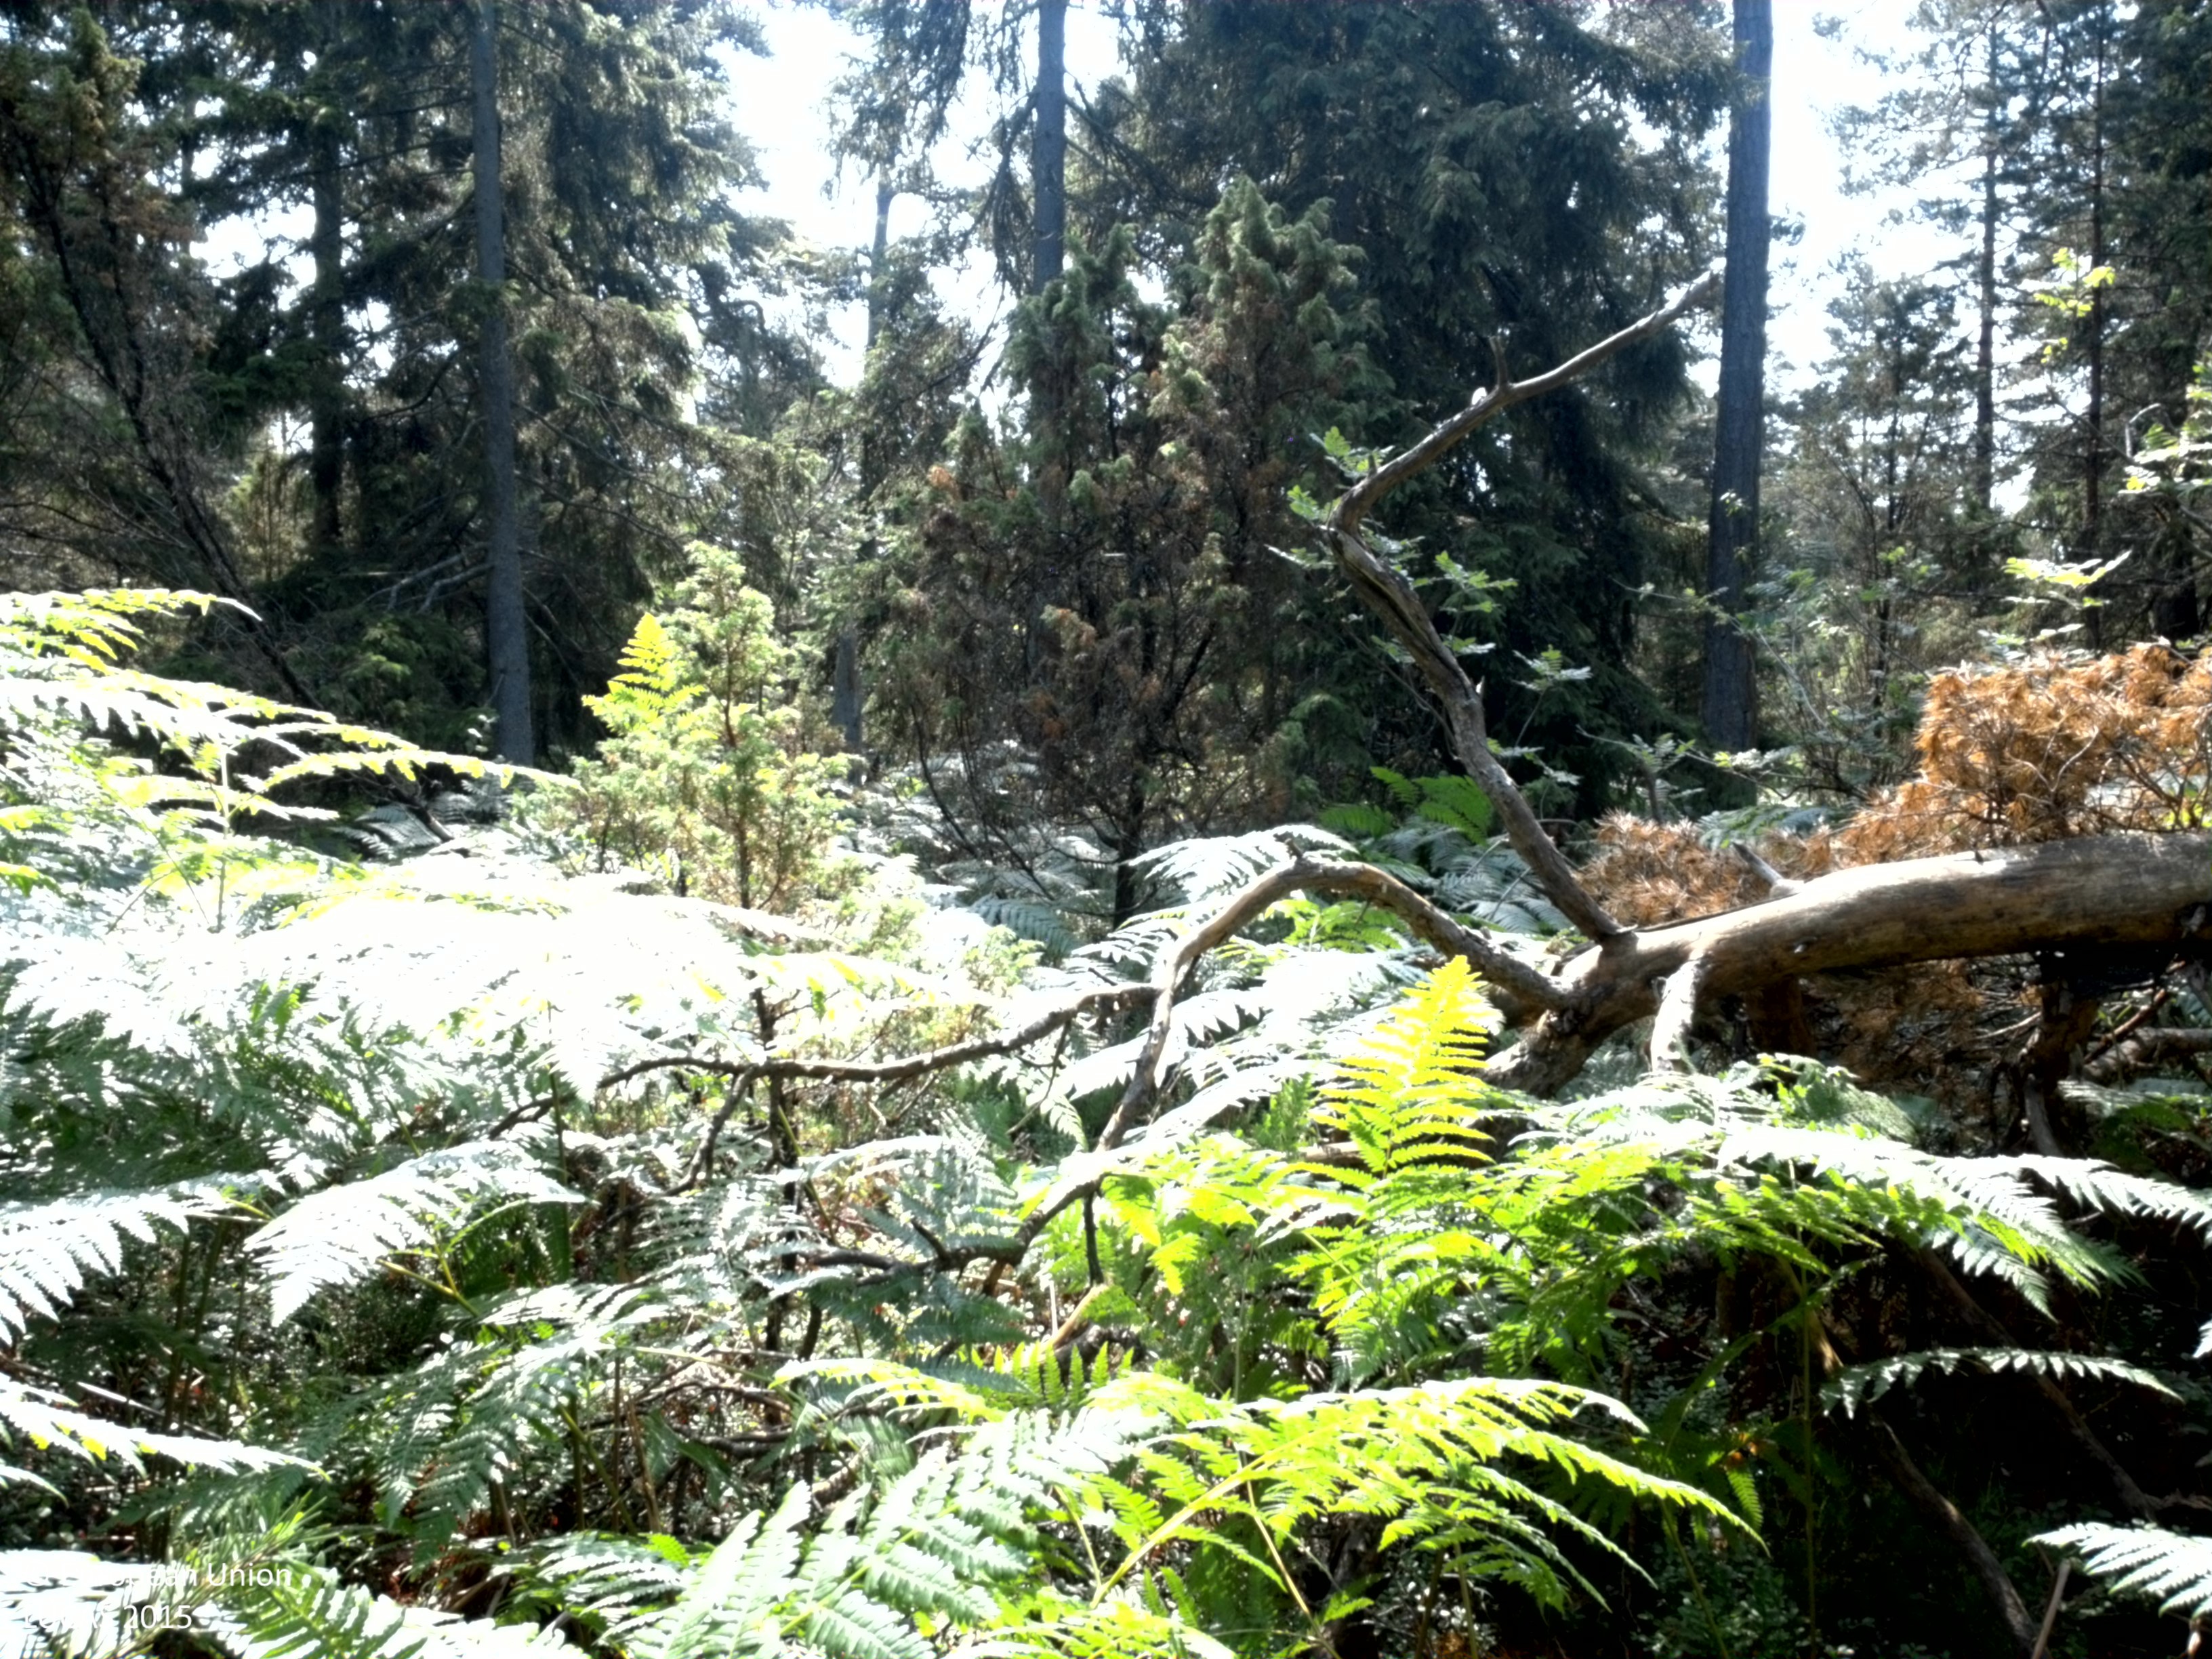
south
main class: Woodland
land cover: Pine dominated coniferous woodland
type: hemiboreal forest and nemoral coniferous forest and mixed broadleaved-coniferous forest
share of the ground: 50 - 75 %
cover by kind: coniferous forest trees 65 %, herbaceous plants 30 %, shrubs 5 %
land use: Forestry
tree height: > 5 m
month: July
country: SE
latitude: 57.3888
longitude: 18.7785
